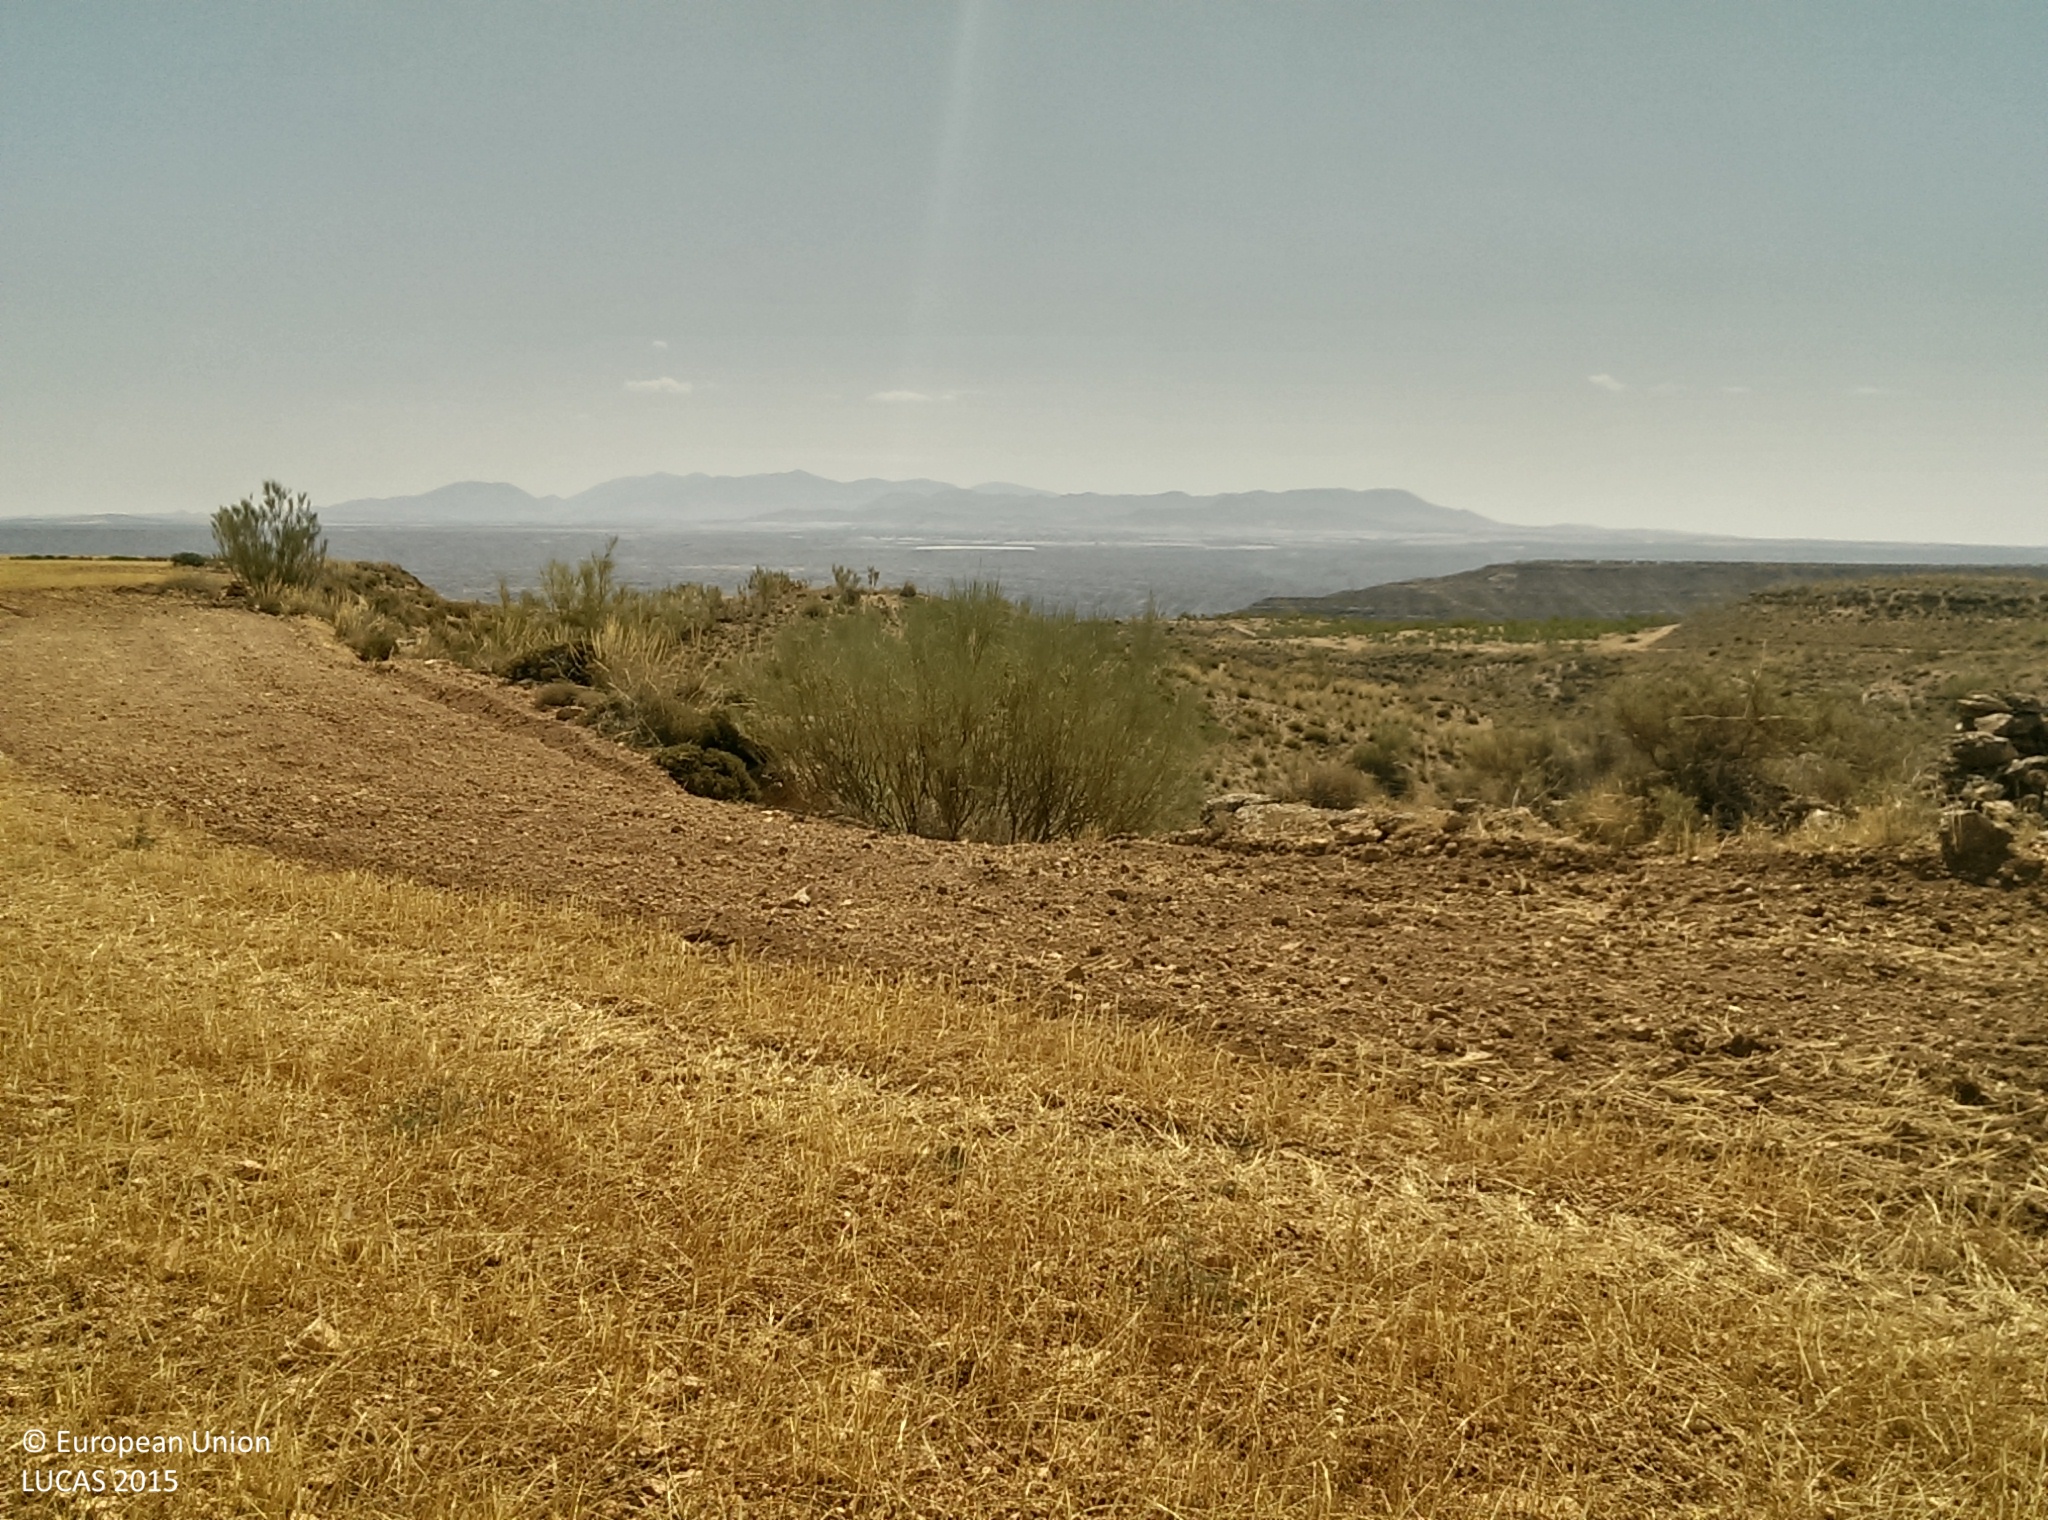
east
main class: Cropland
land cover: Barley
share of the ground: < 10 %
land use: Agriculture (excluding fallow land and kitchen gardens)
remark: Harvested field
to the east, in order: Barley; Other bare soil; Shrubland without tree cover; Grassland without tree/shrub cover
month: July
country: ES
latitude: 37.3897
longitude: -3.2155
